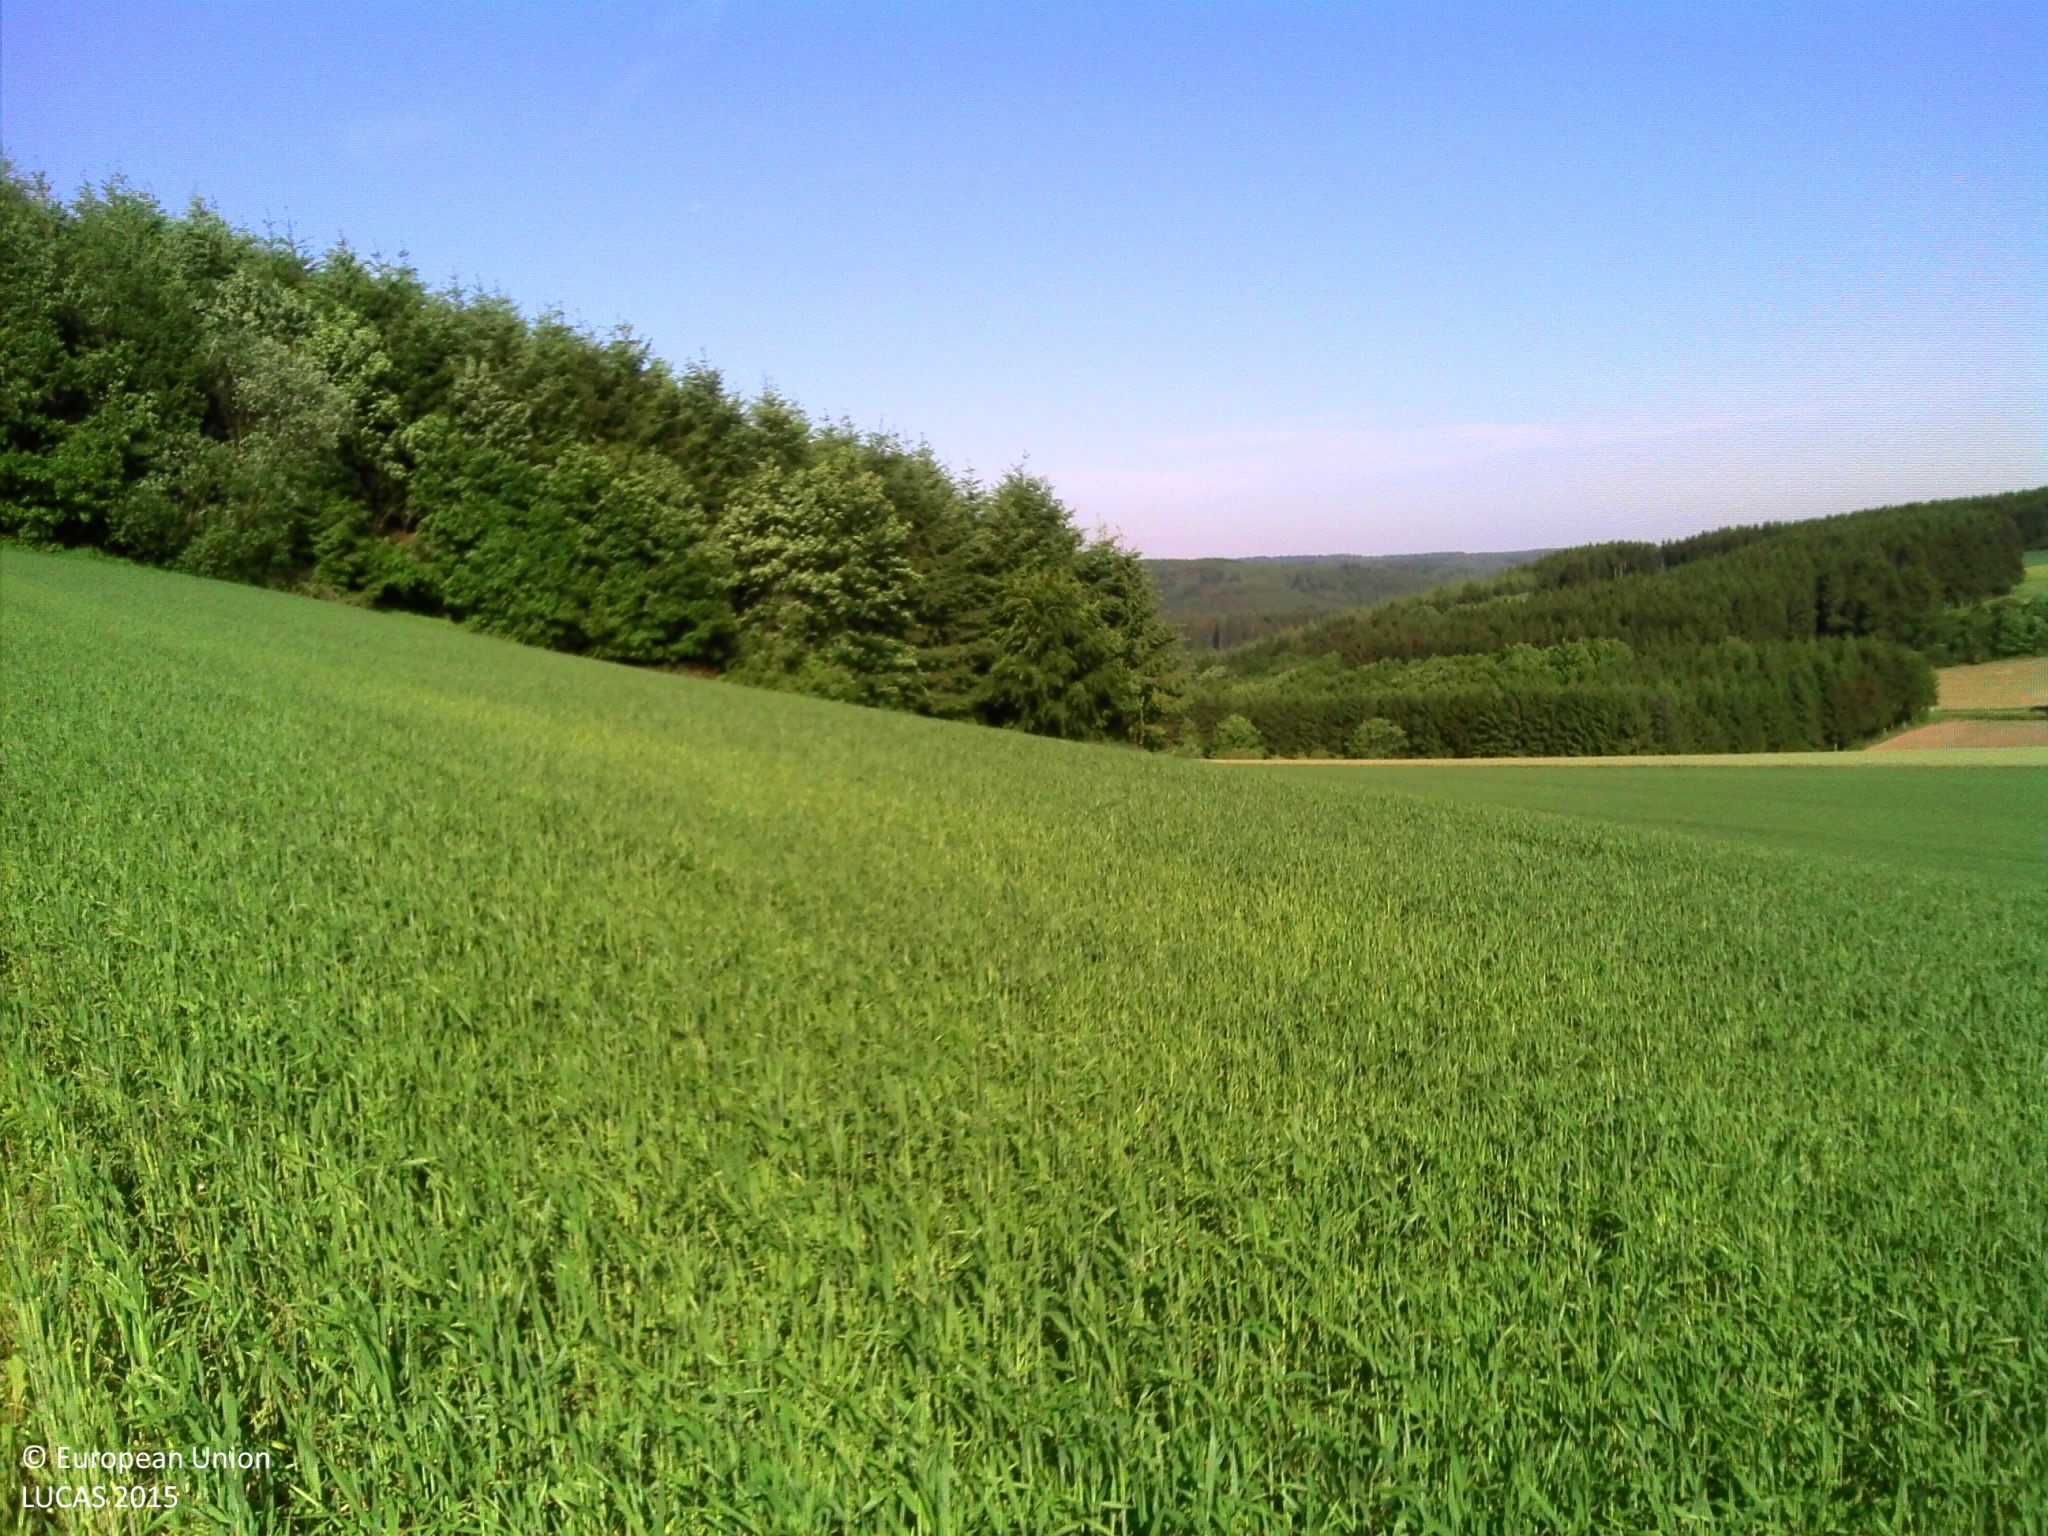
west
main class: Cropland
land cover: Triticale
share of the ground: > 75 %
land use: Agriculture (excluding fallow land and kitchen gardens)
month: June
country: LU
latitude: 49.8732
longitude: 5.8106
